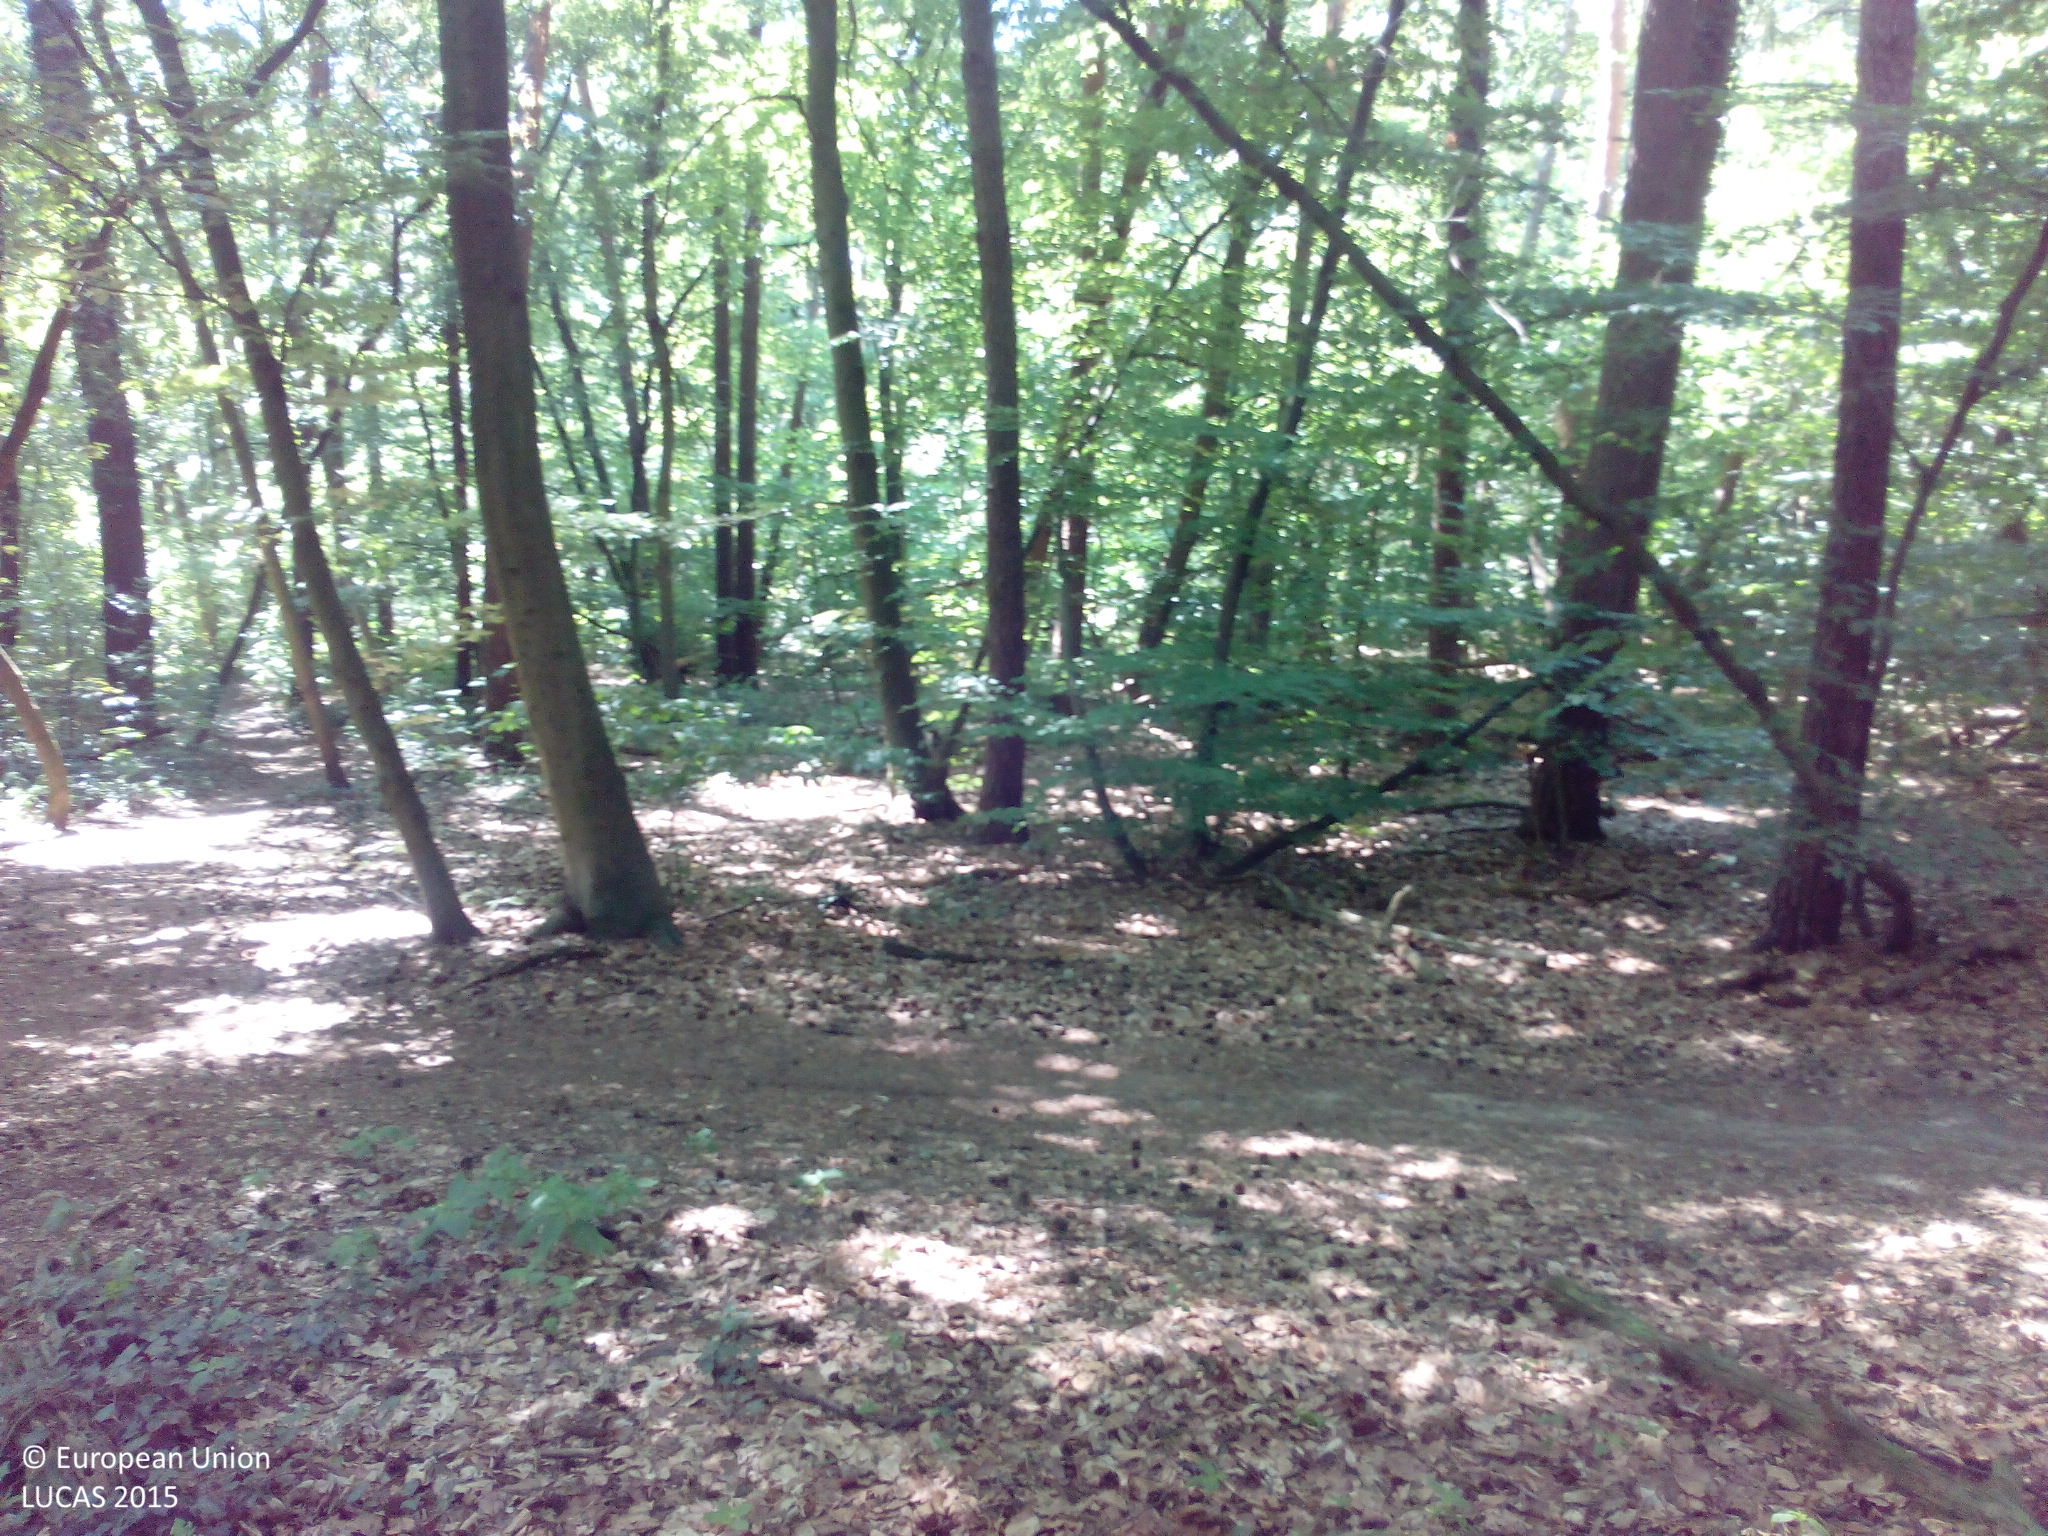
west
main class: Woodland
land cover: Pine dominated mixed woodland
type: mesophytic deciduous forest
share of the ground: > 75 %
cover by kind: broadleaved forest trees 50 %, coniferous forest trees 30 %, herbaceous plants 10 %, unconsolidated bare surface 10 %
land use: Forestry
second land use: Amenities, museums, leisure
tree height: > 5 m
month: July
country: DE
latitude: 49.8345
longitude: 8.6518
